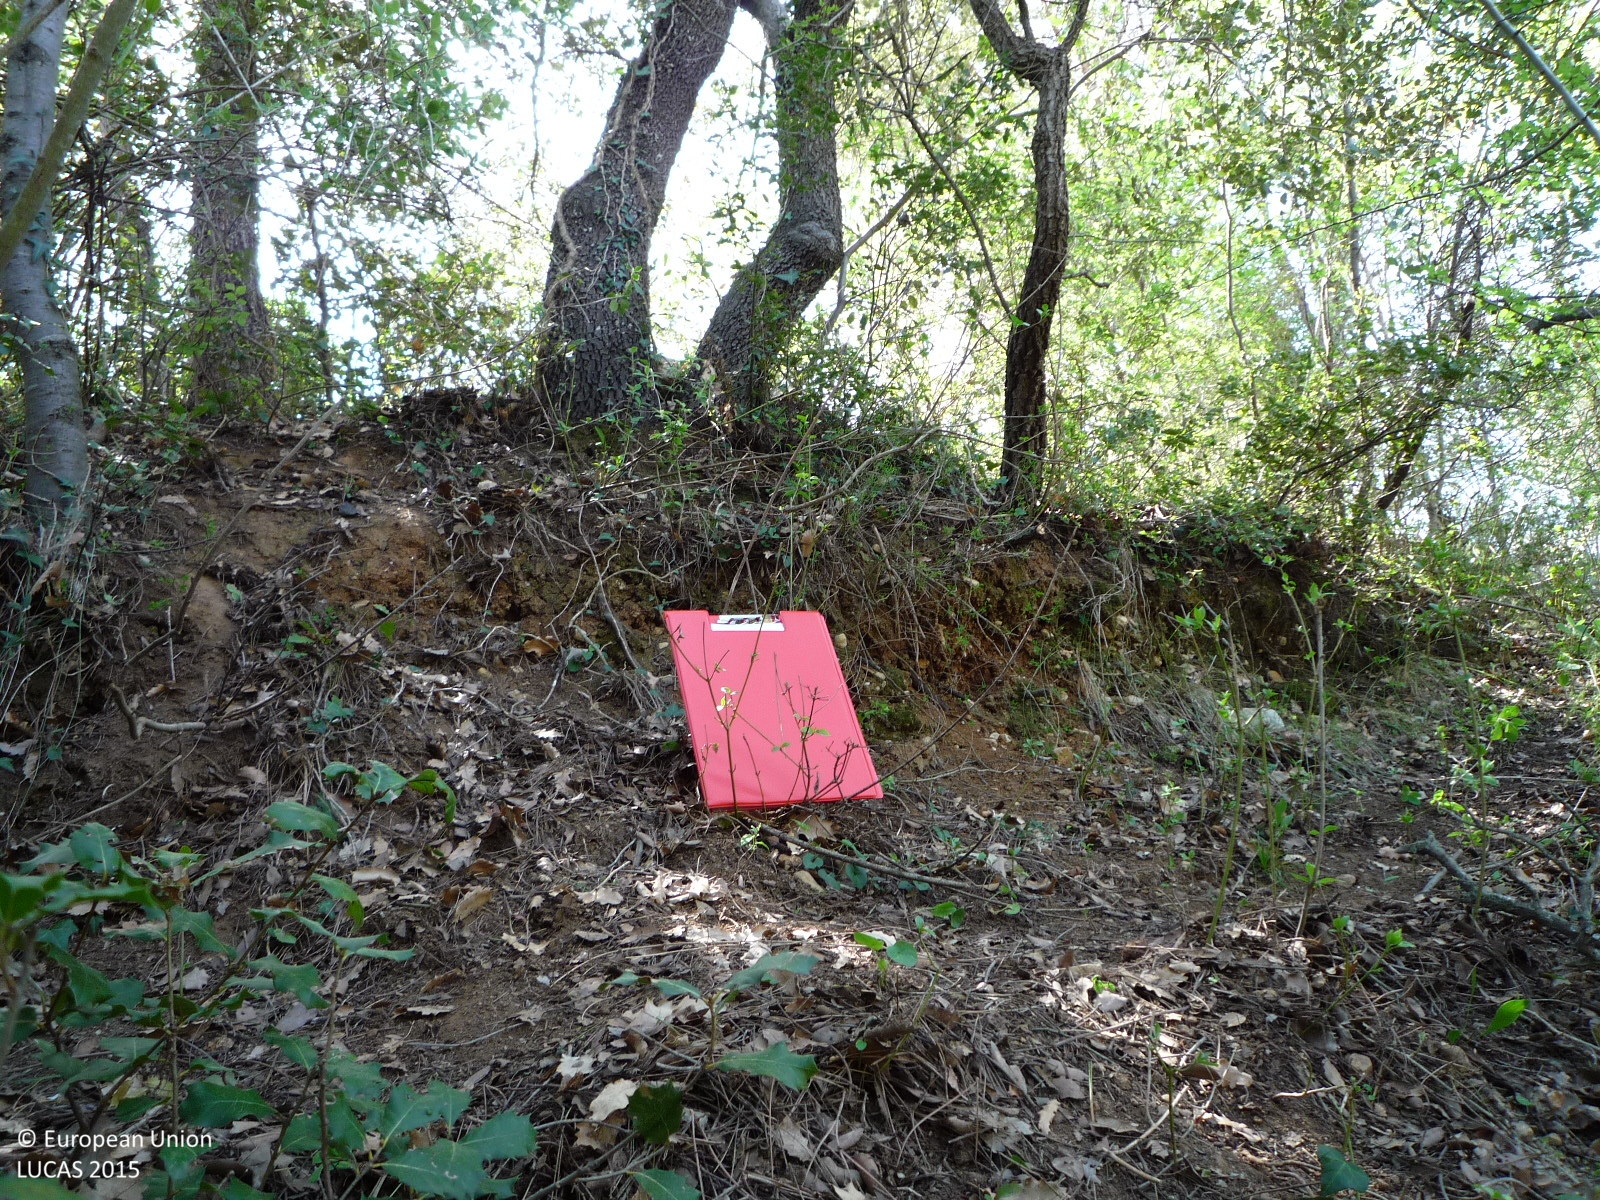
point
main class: Woodland
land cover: Pine dominated mixed woodland
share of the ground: > 75 %
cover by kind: coniferous forest trees 55 %, broadleaved forest trees 45 %
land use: Semi-natural and natural areas not in use
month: April
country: ES
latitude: 41.5292
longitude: 1.6626
